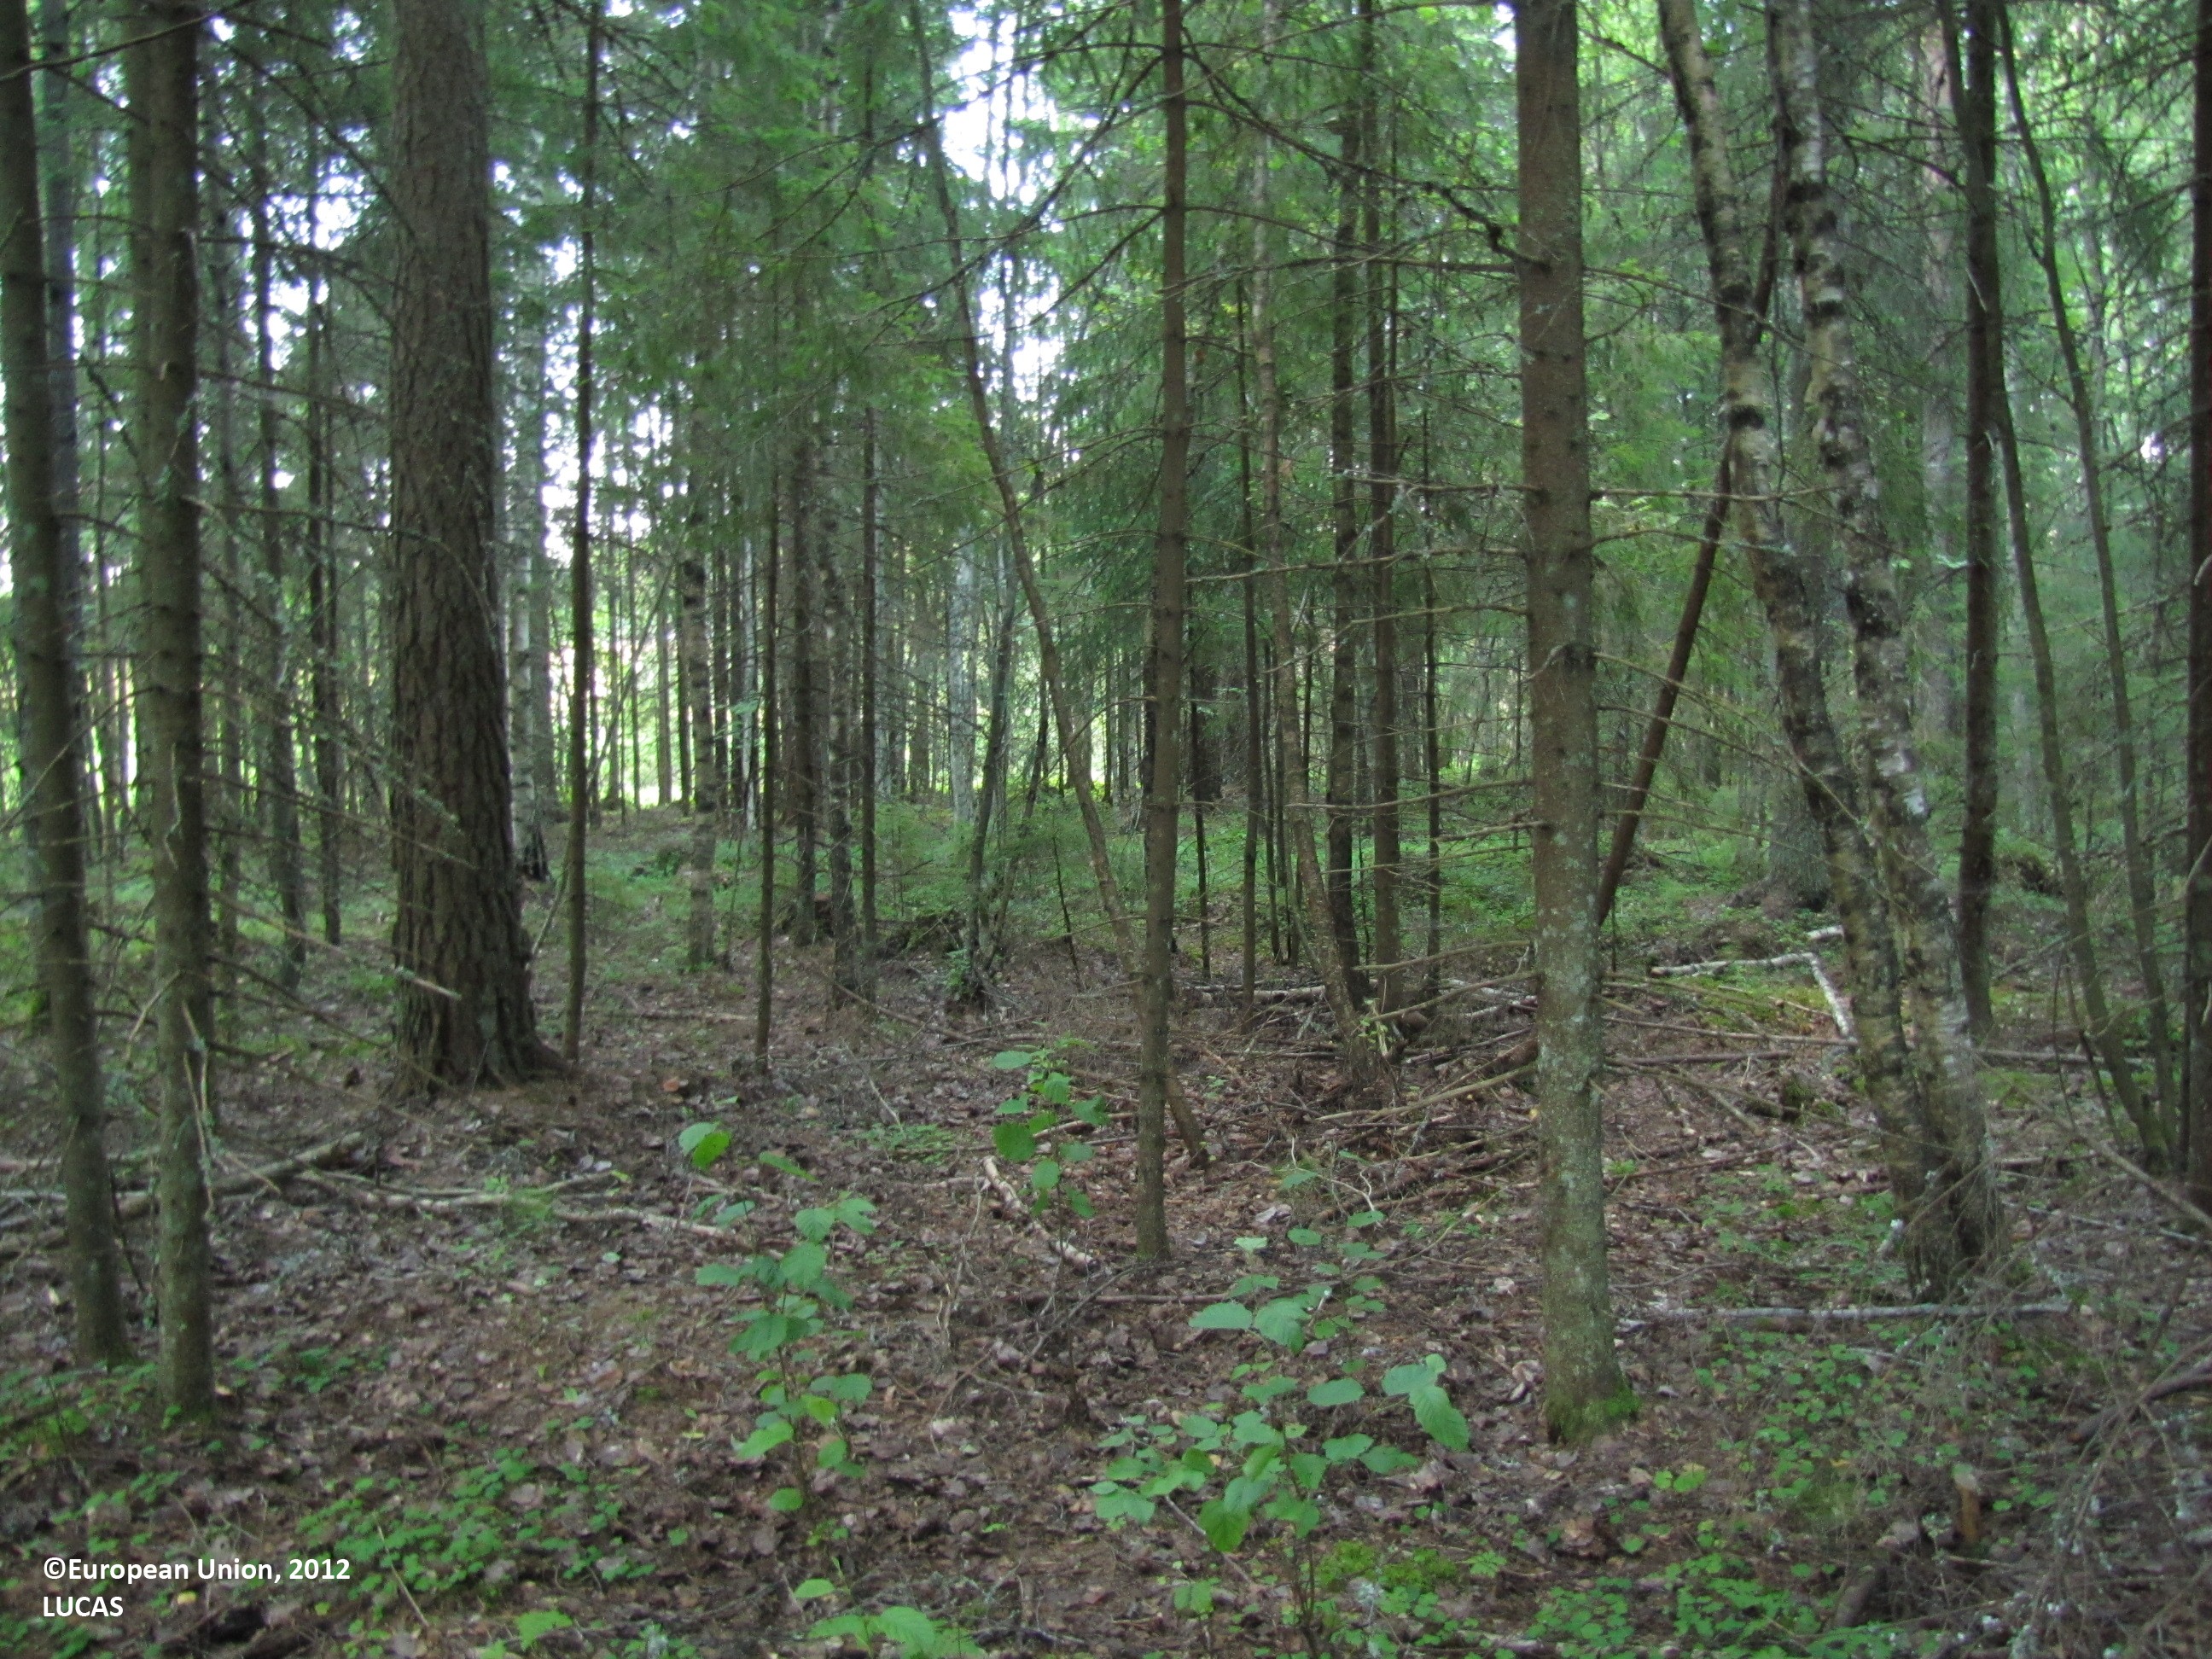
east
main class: Woodland
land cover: Spruce dominated coniferous woodland
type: boreal forest
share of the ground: > 75 %
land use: Forestry
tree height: > 5 m
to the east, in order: Spruce dominated coniferous woodland; Tracks; Spruce dominated coniferous woodland; Grassland without tree/shrub cover; Ditches and canals; Abandoned hedges; Temporary grasslands; Ditches and canals; Abandoned hedges; Temporary grasslands; Ditches and canals; Abandoned hedges; Temporary grasslands
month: August
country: FI
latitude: 61.7732
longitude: 22.9756
